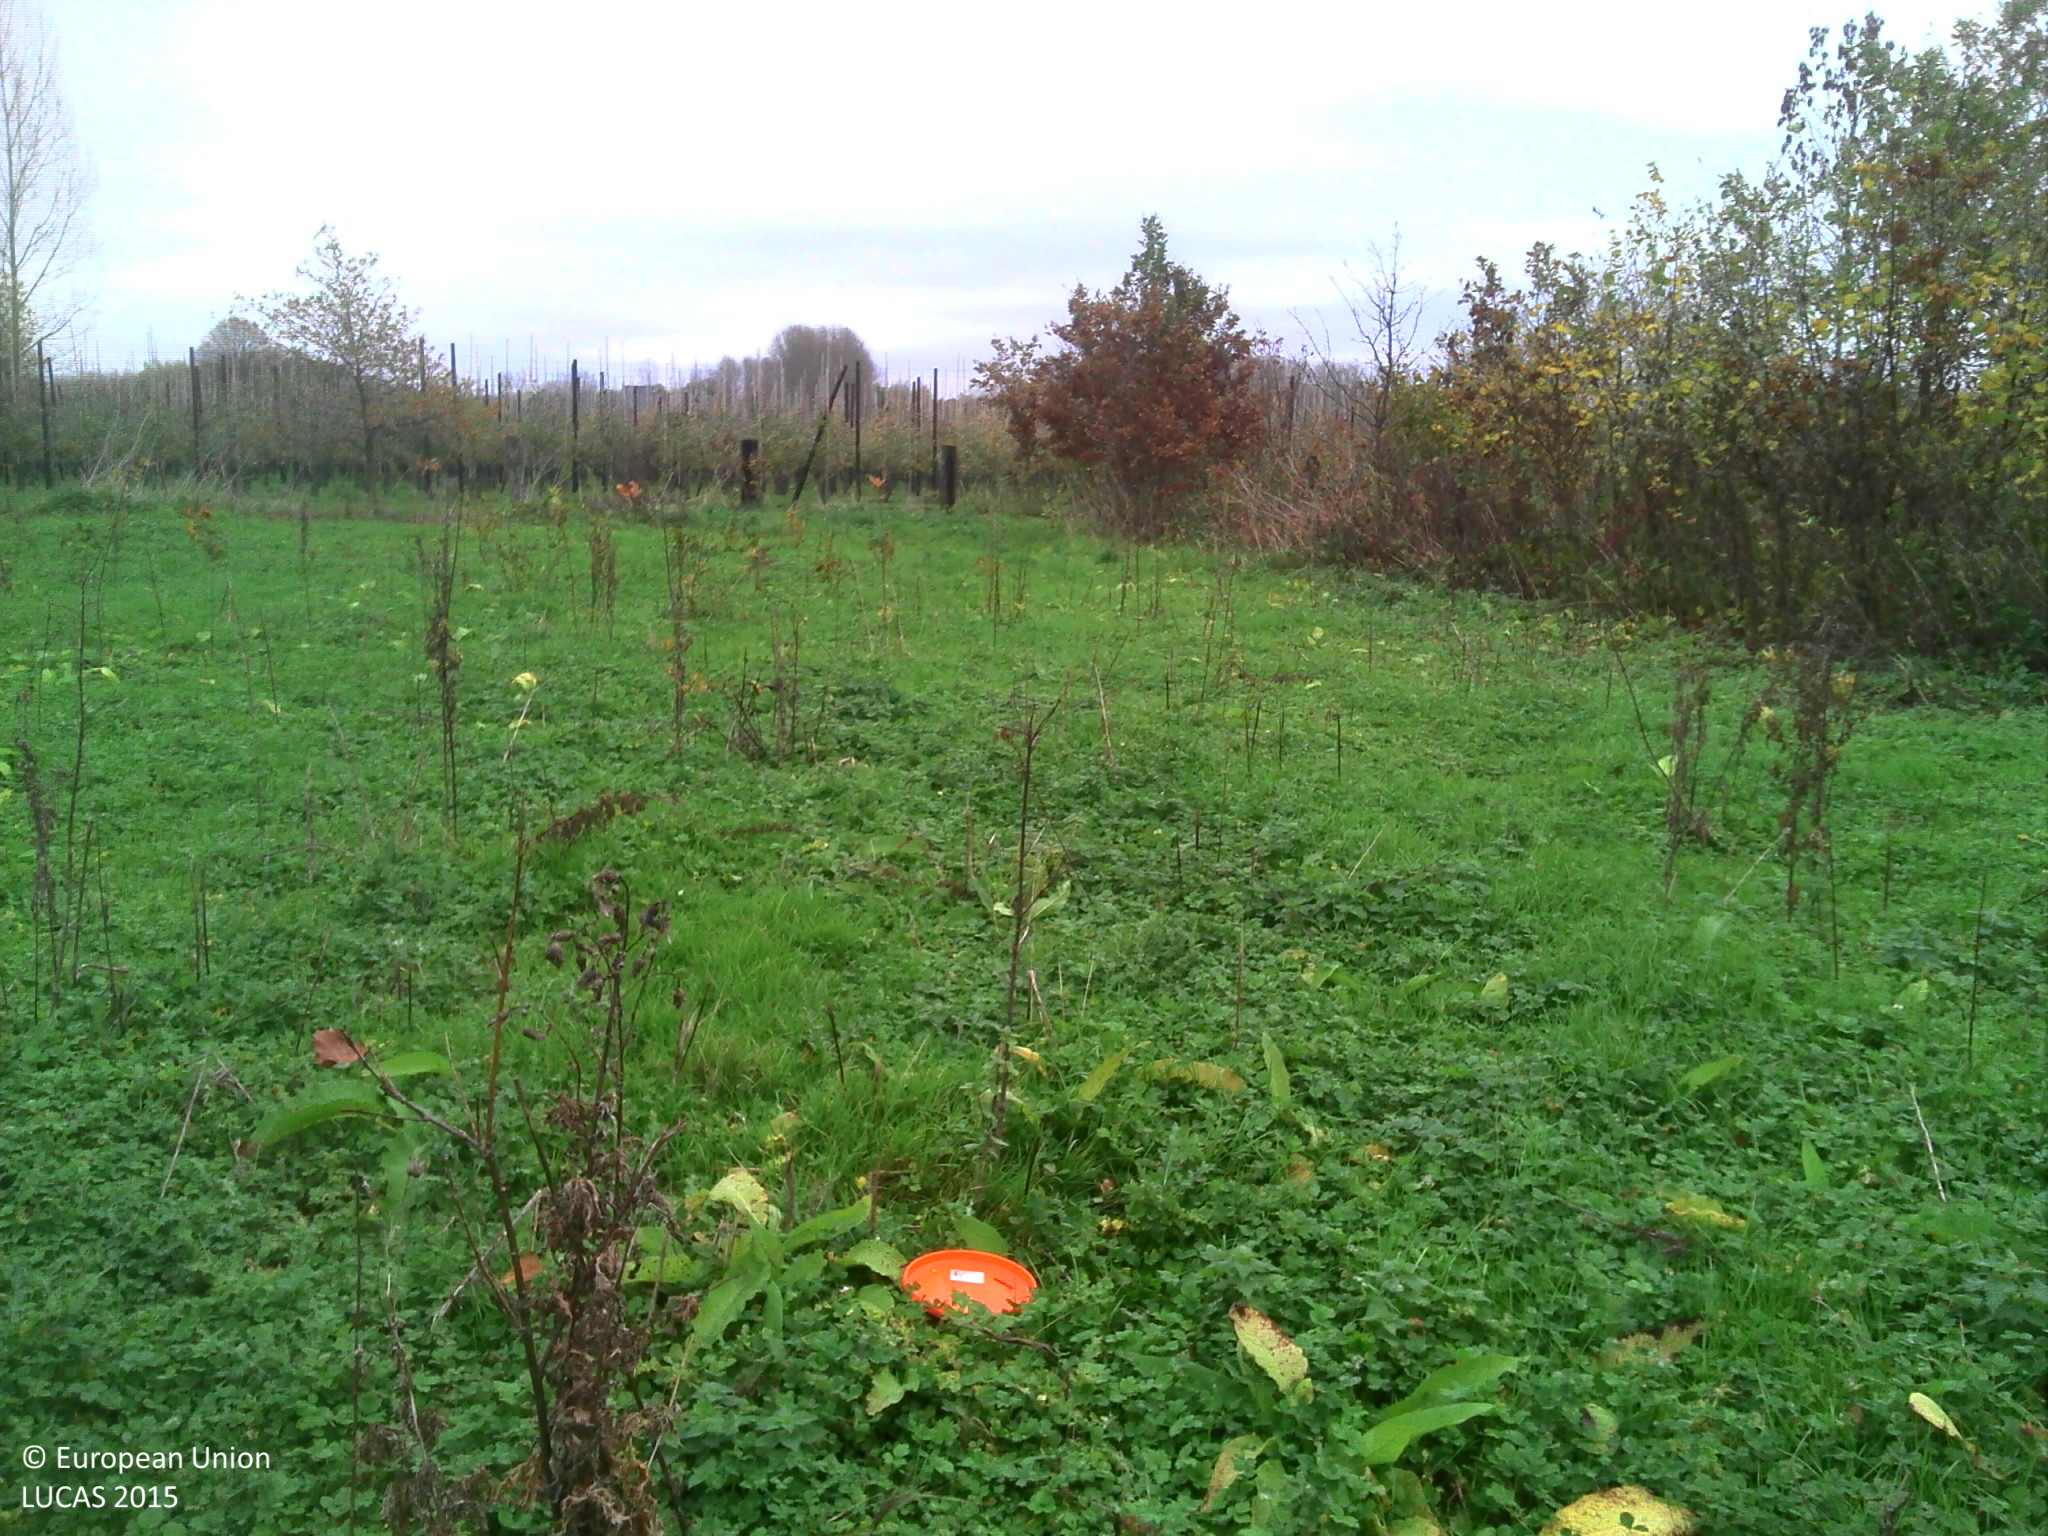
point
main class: Grassland
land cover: Grassland without tree/shrub cover
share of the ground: > 75 %
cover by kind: herbaceous plants 100 %
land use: Agriculture (excluding fallow land and kitchen gardens)
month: November
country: BE
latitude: 50.9613
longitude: 4.6856
